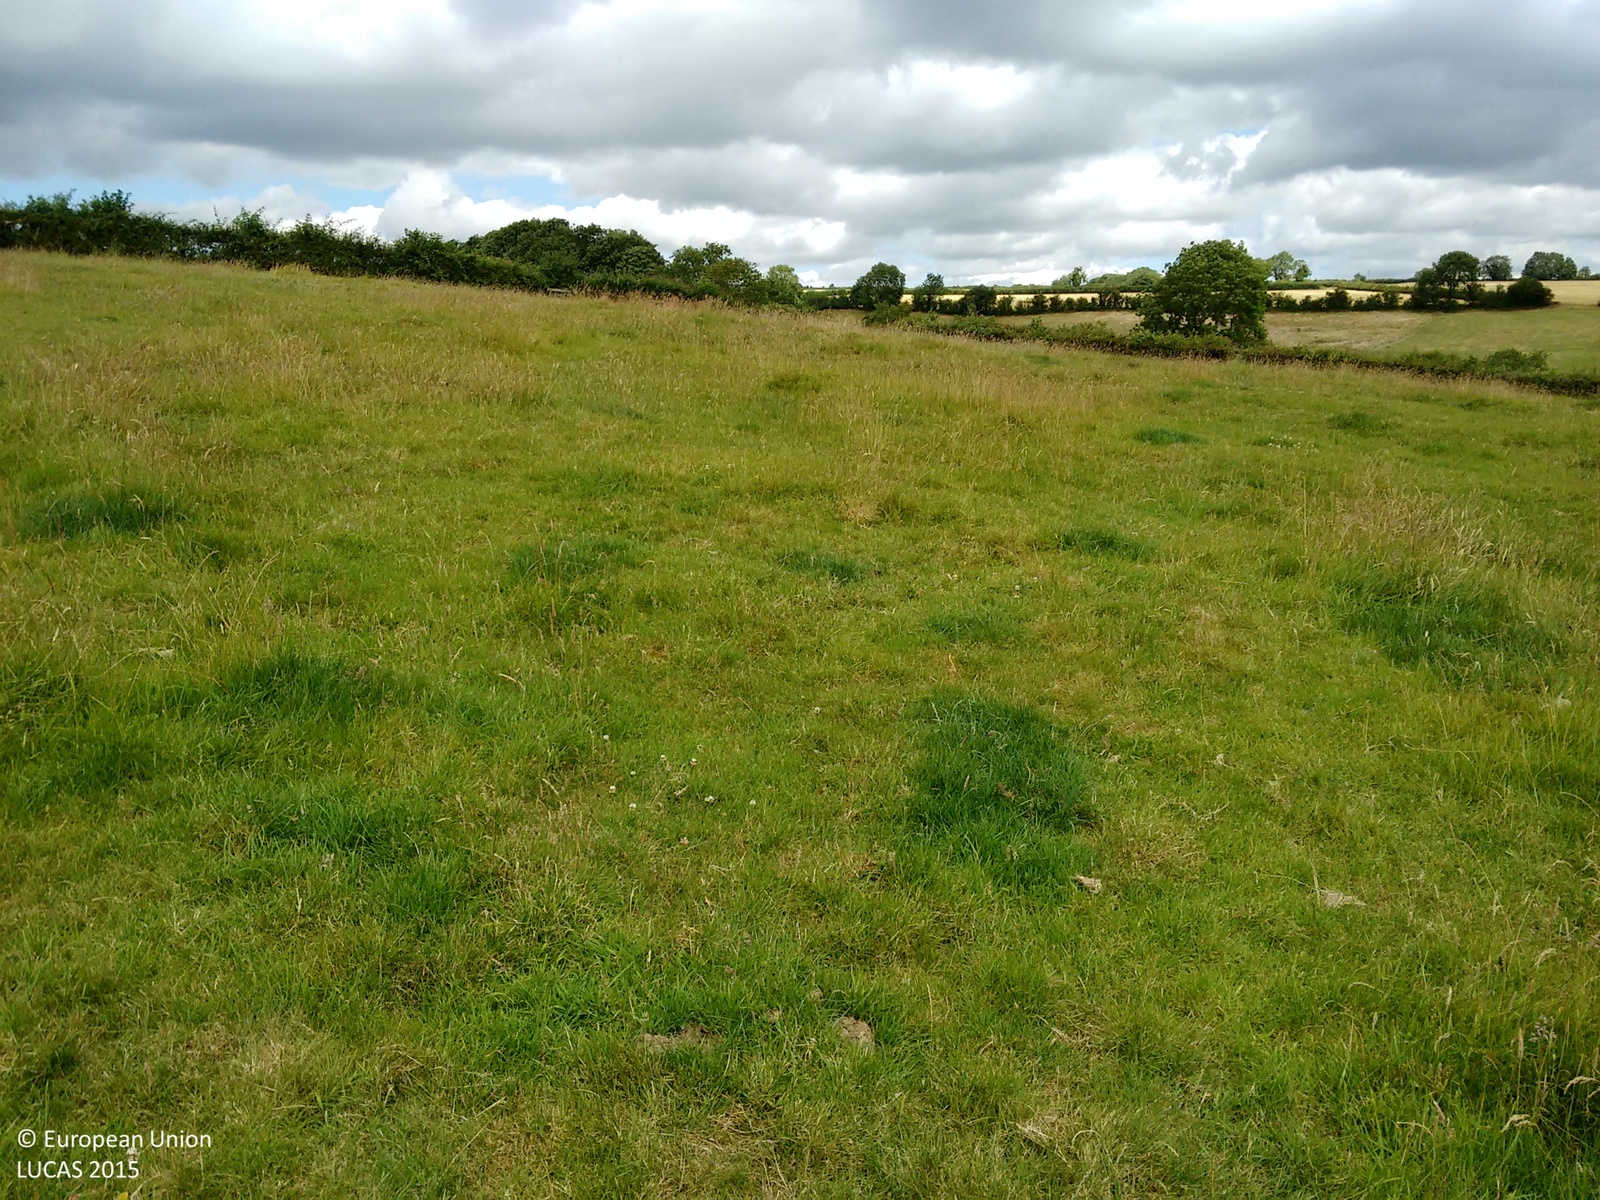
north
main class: Grassland
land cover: Grassland without tree/shrub cover
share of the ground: > 75 %
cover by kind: herbaceous plants 100 %
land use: Agriculture (excluding fallow land and kitchen gardens)
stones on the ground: < 10 %
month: July
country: GB
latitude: 51.9528
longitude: -1.5910
